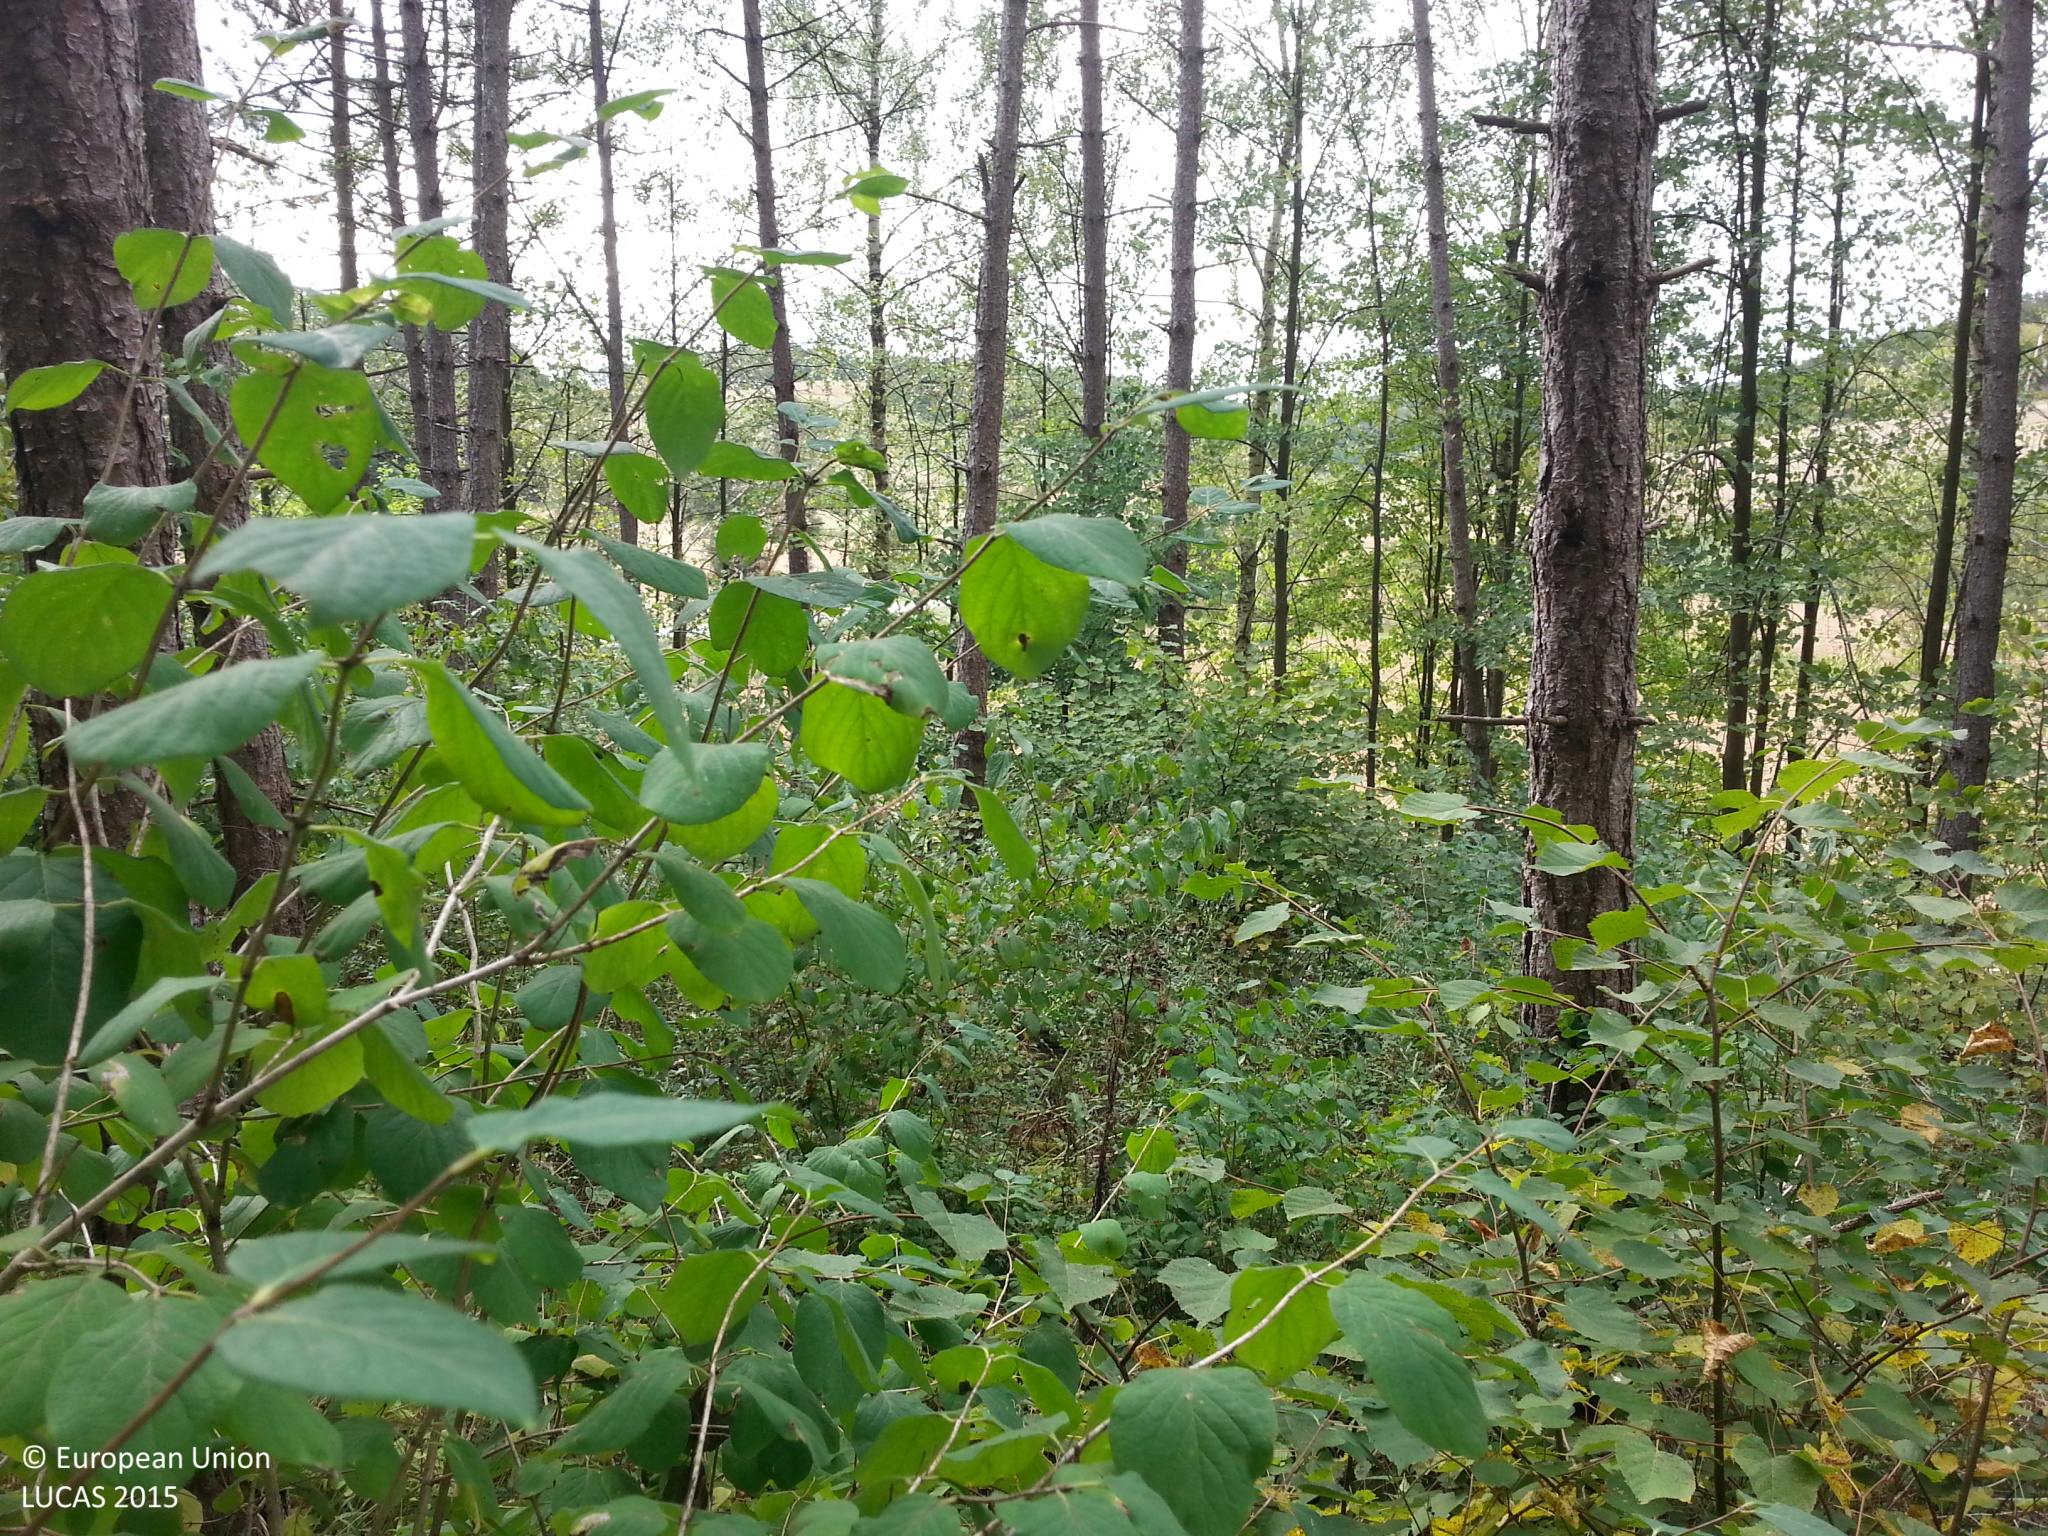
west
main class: Woodland
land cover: Pine dominated mixed woodland
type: hemiboreal forest and nemoral coniferous forest and mixed broadleaved-coniferous forest
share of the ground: 50 - 75 %
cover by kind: coniferous forest trees 40 %, broadleaved forest trees 30 %, shrubs 20 %, herbaceous plants 5 %, lichens and mosses 5 %
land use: Forestry
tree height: > 5 m
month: September
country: DE
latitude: 49.5900
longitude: 9.5713
